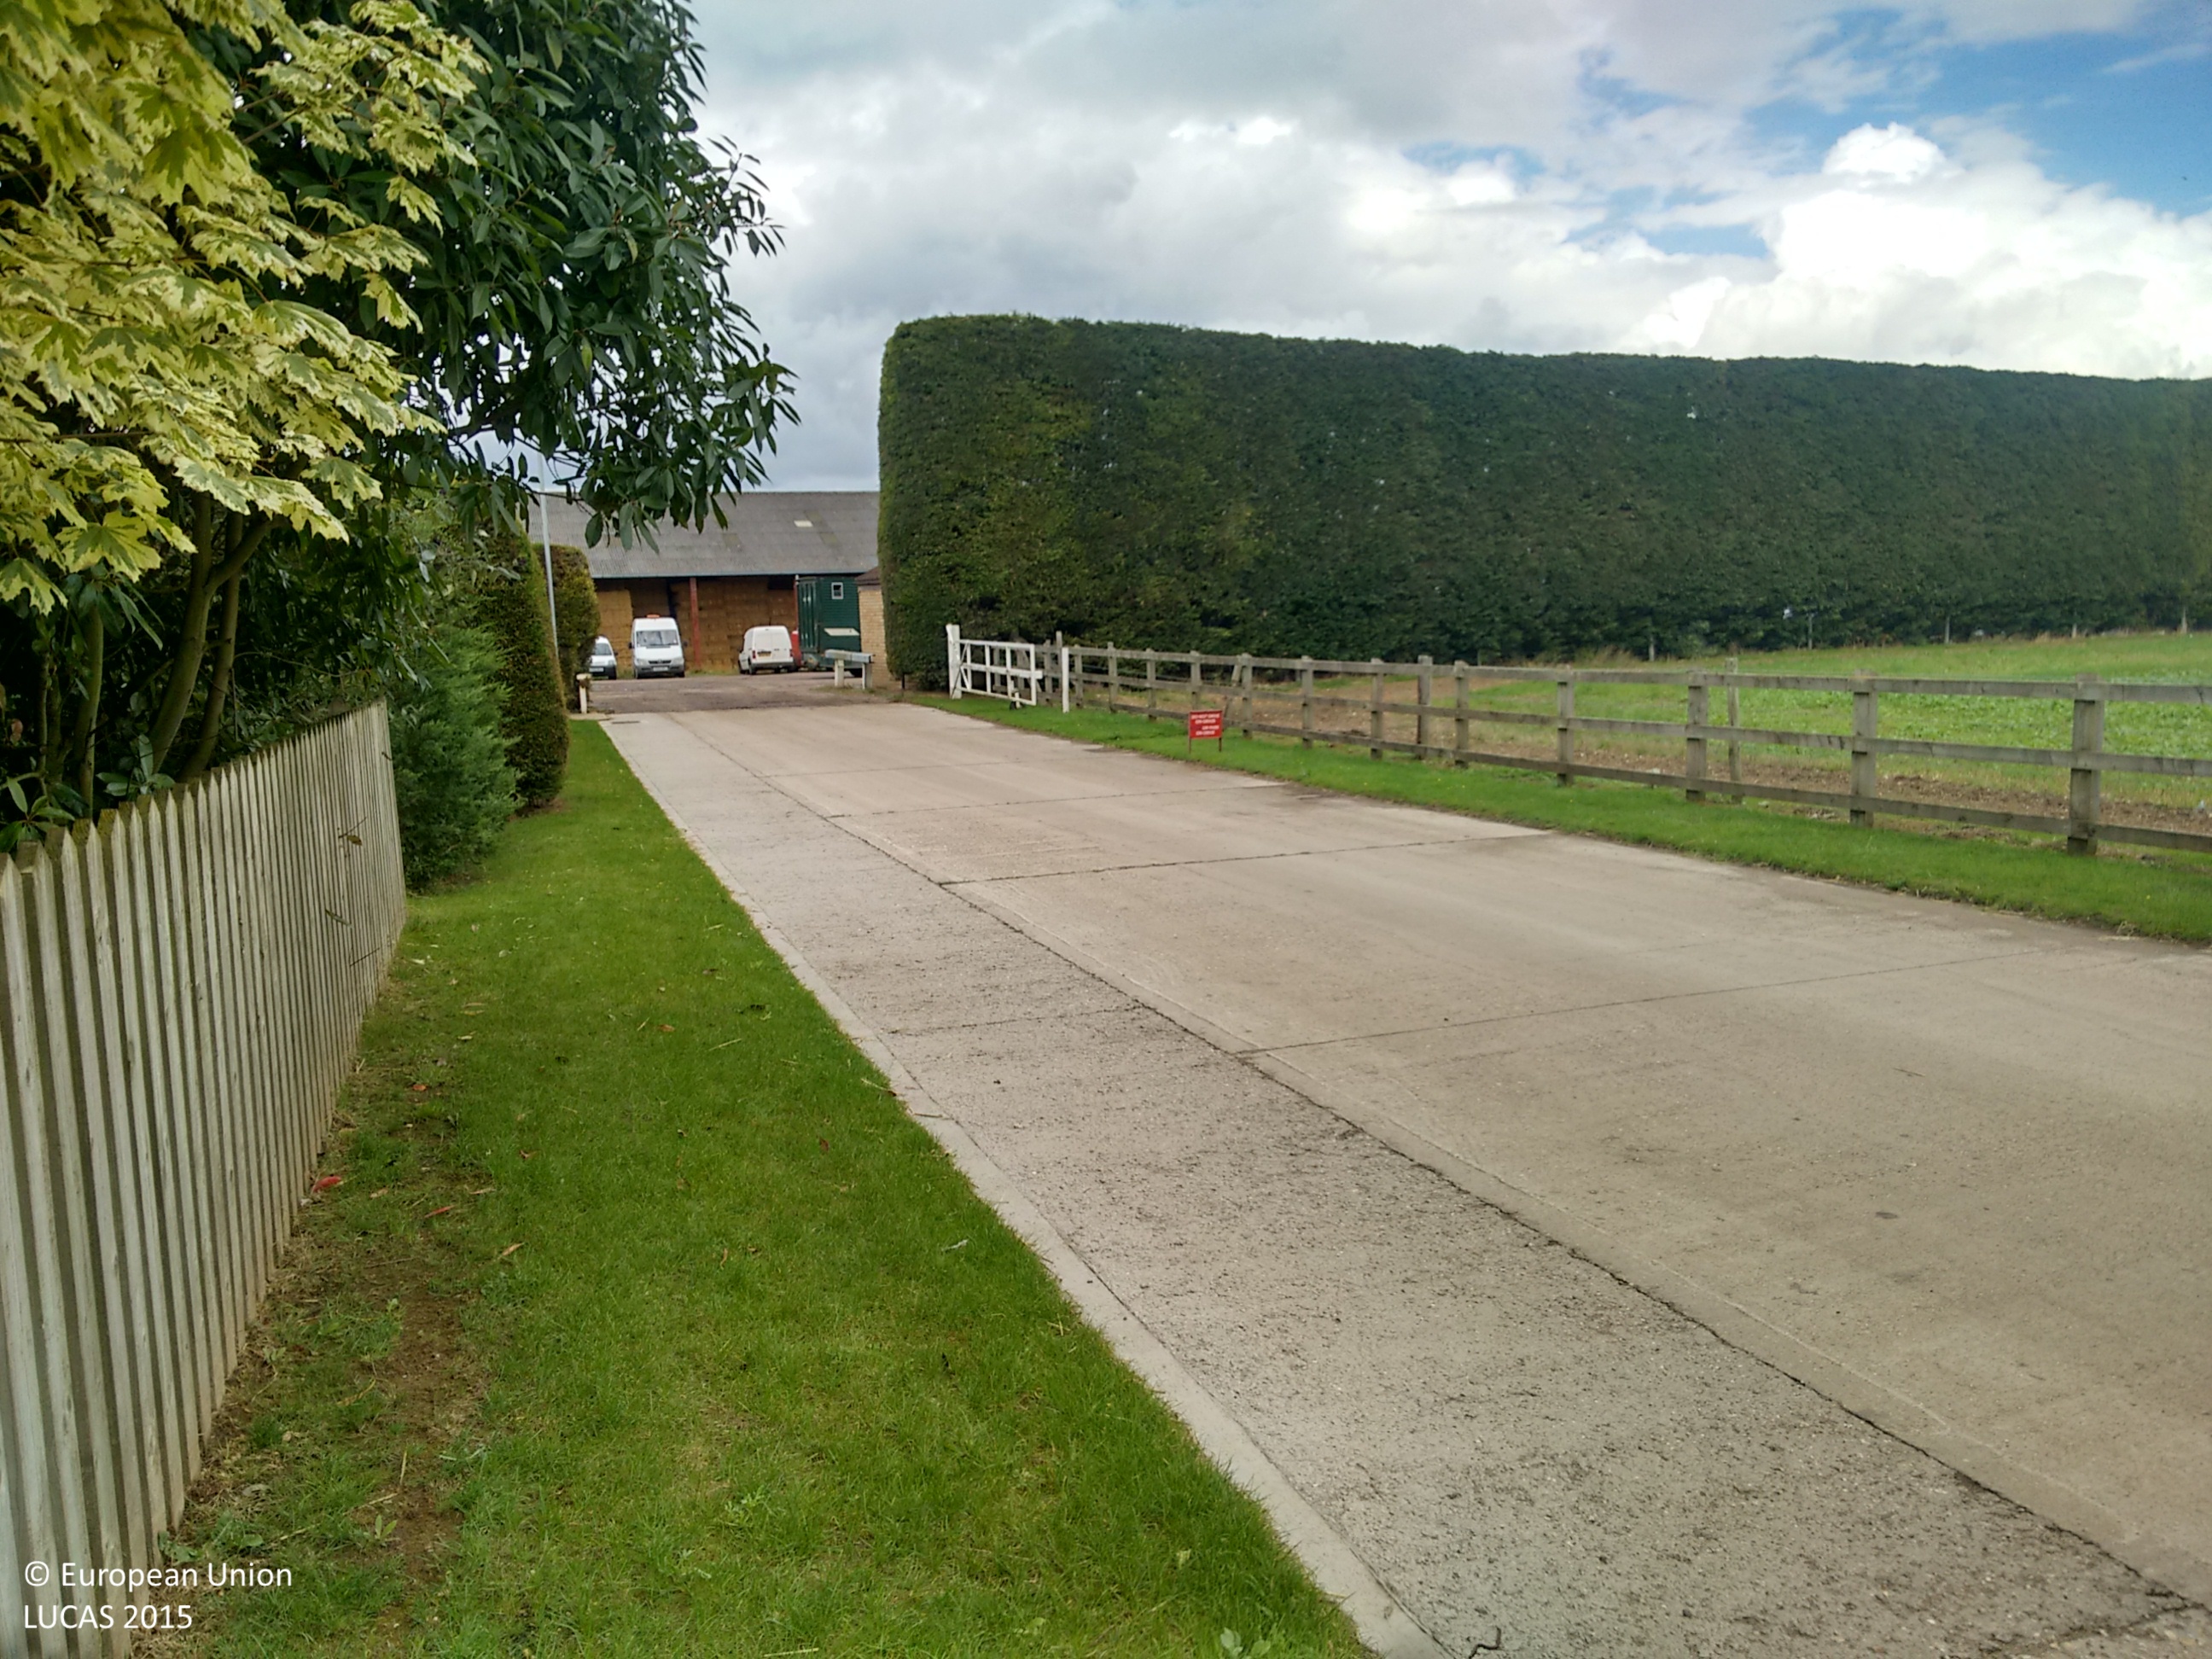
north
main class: Grassland
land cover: Grassland with sparse tree/shrub cover
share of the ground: > 75 %
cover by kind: herbaceous plants 85 %, shrubs 10 %, broadleaved forest trees 5 %
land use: Residential
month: September
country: GB
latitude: 52.3153
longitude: 0.4219
